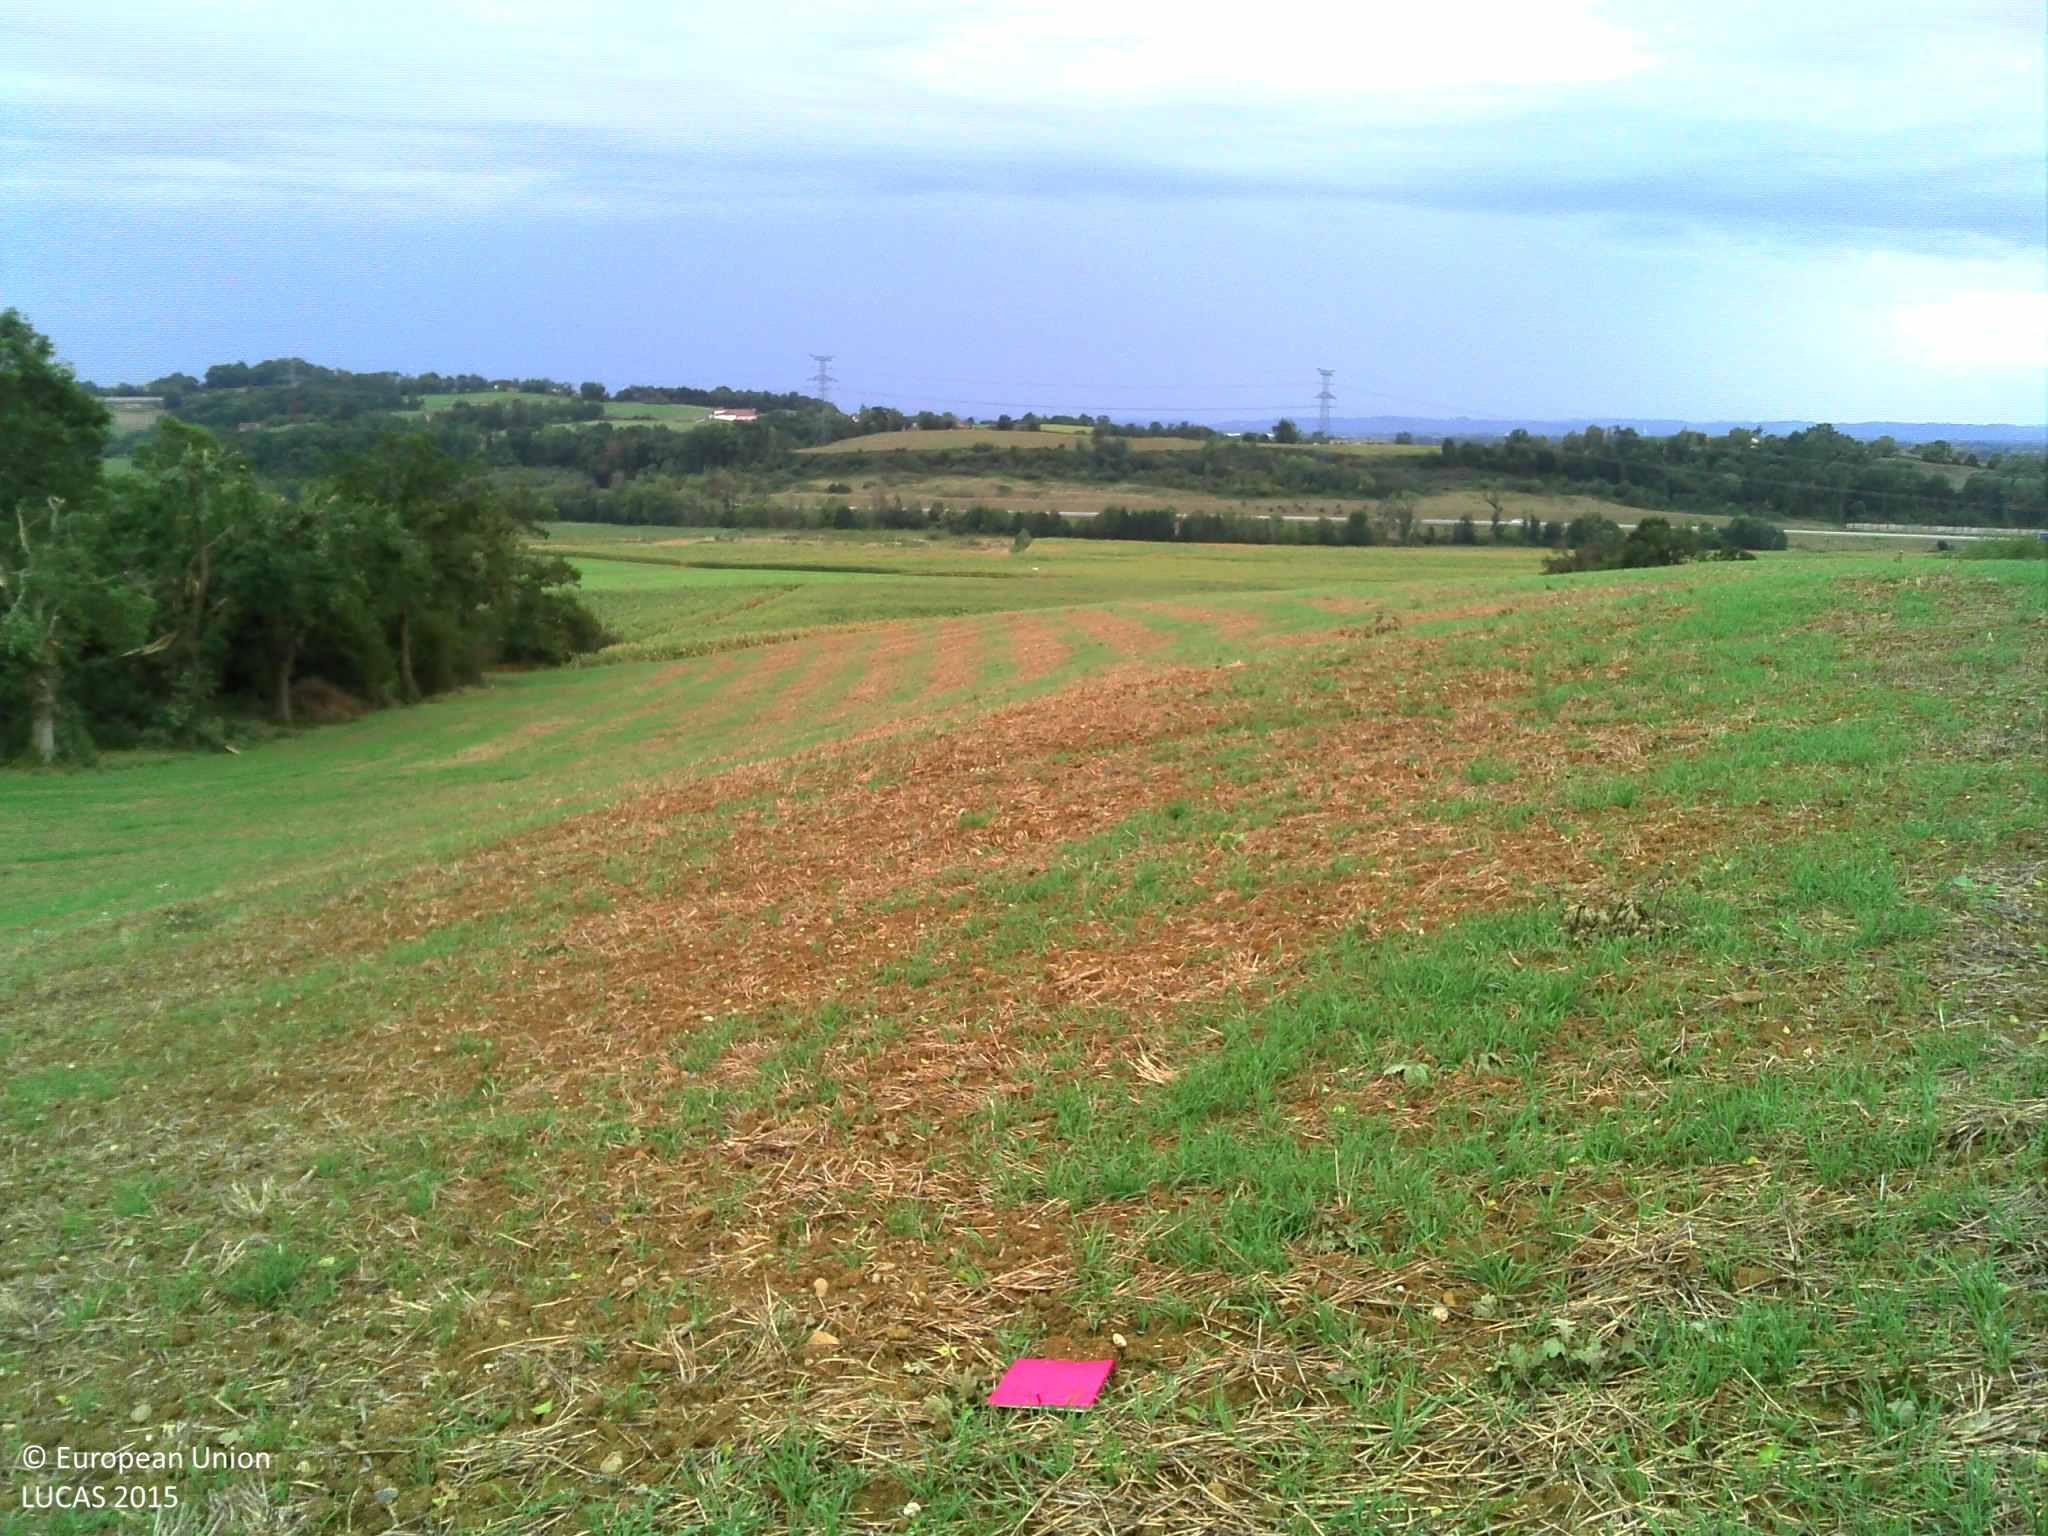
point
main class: Cropland
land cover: Common wheat
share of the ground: > 75 %
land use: Agriculture (excluding fallow land and kitchen gardens)
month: September
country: FR
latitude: 43.4424
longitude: -0.4241
